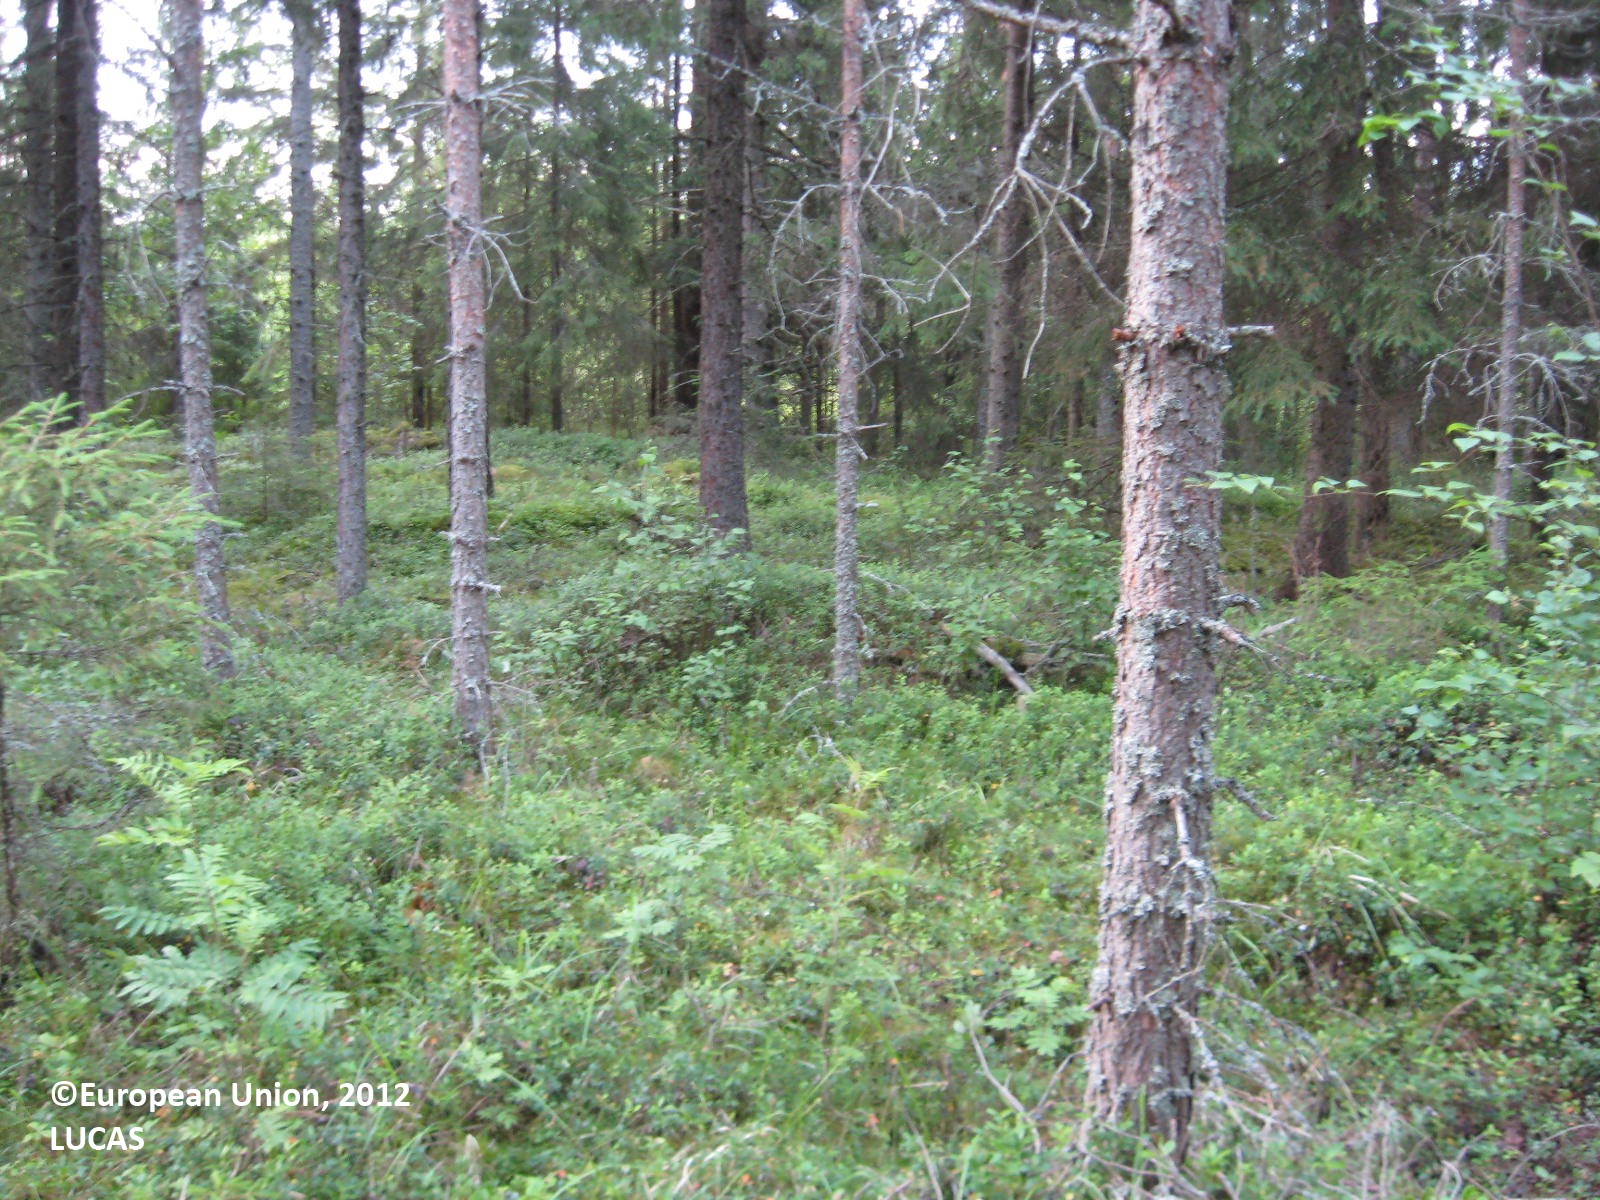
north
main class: Woodland
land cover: Pine dominated coniferous woodland
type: boreal forest
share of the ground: > 75 %
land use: Forestry
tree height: > 5 m
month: July
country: FI
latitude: 62.5893
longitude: 21.5111
